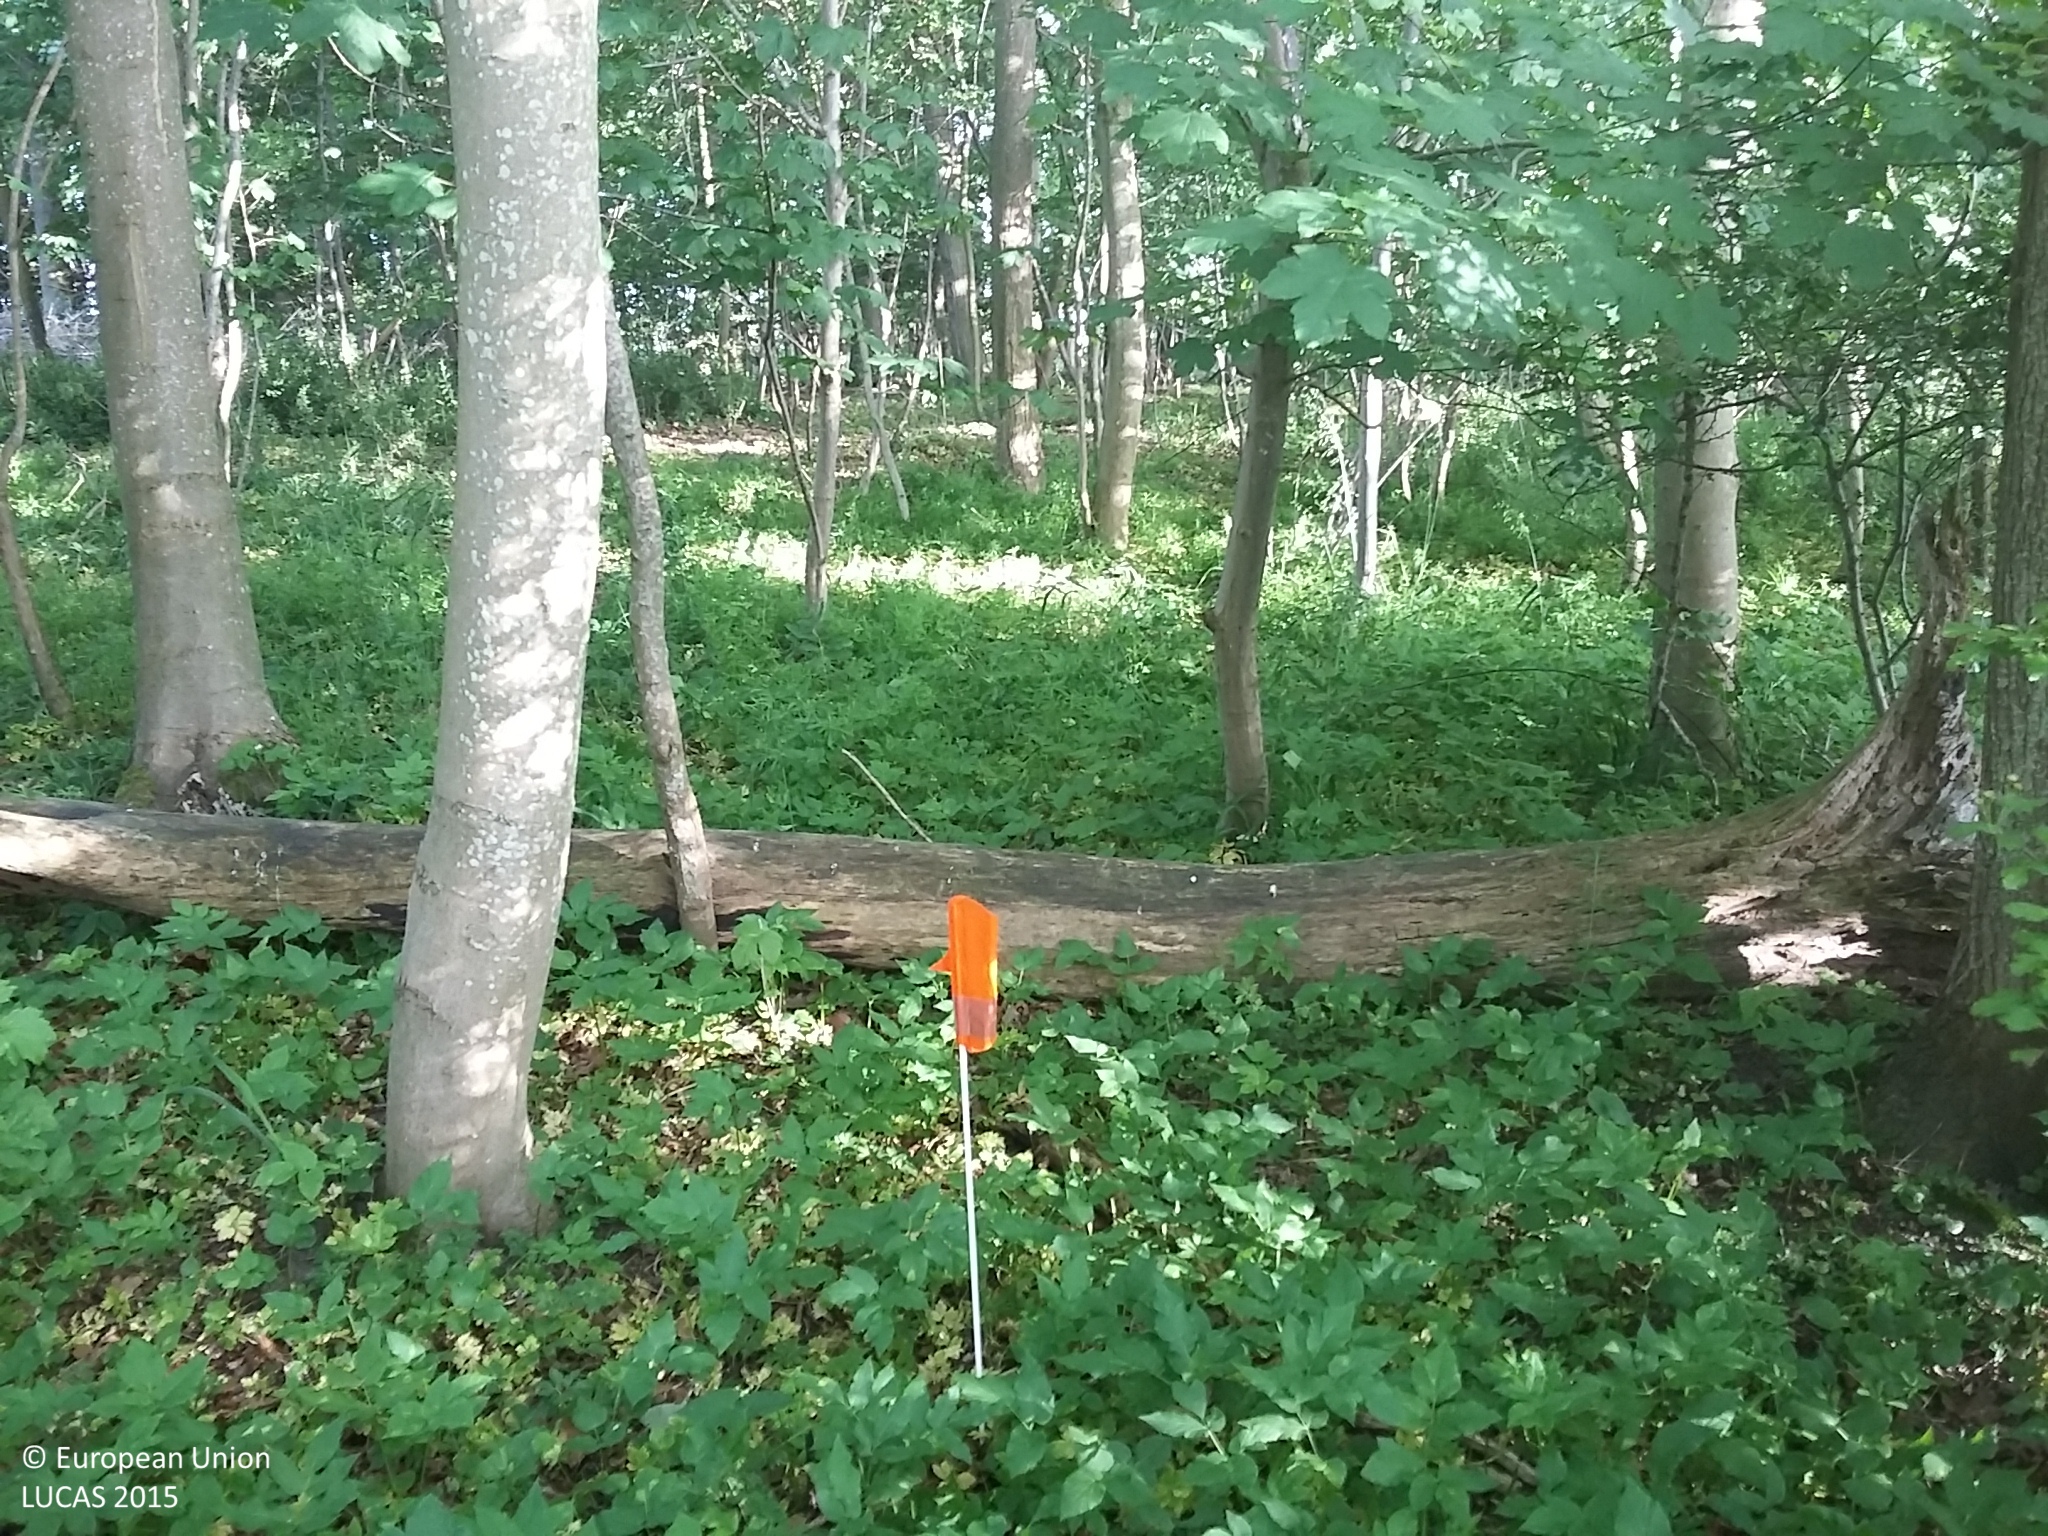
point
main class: Woodland
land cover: Broadleaved woodland
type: beech forest
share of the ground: > 75 %
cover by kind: broadleaved forest trees 85 %, herbaceous plants 15 %
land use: Forestry
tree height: > 5 m
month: June
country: DK
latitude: 55.3774
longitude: 10.6149
